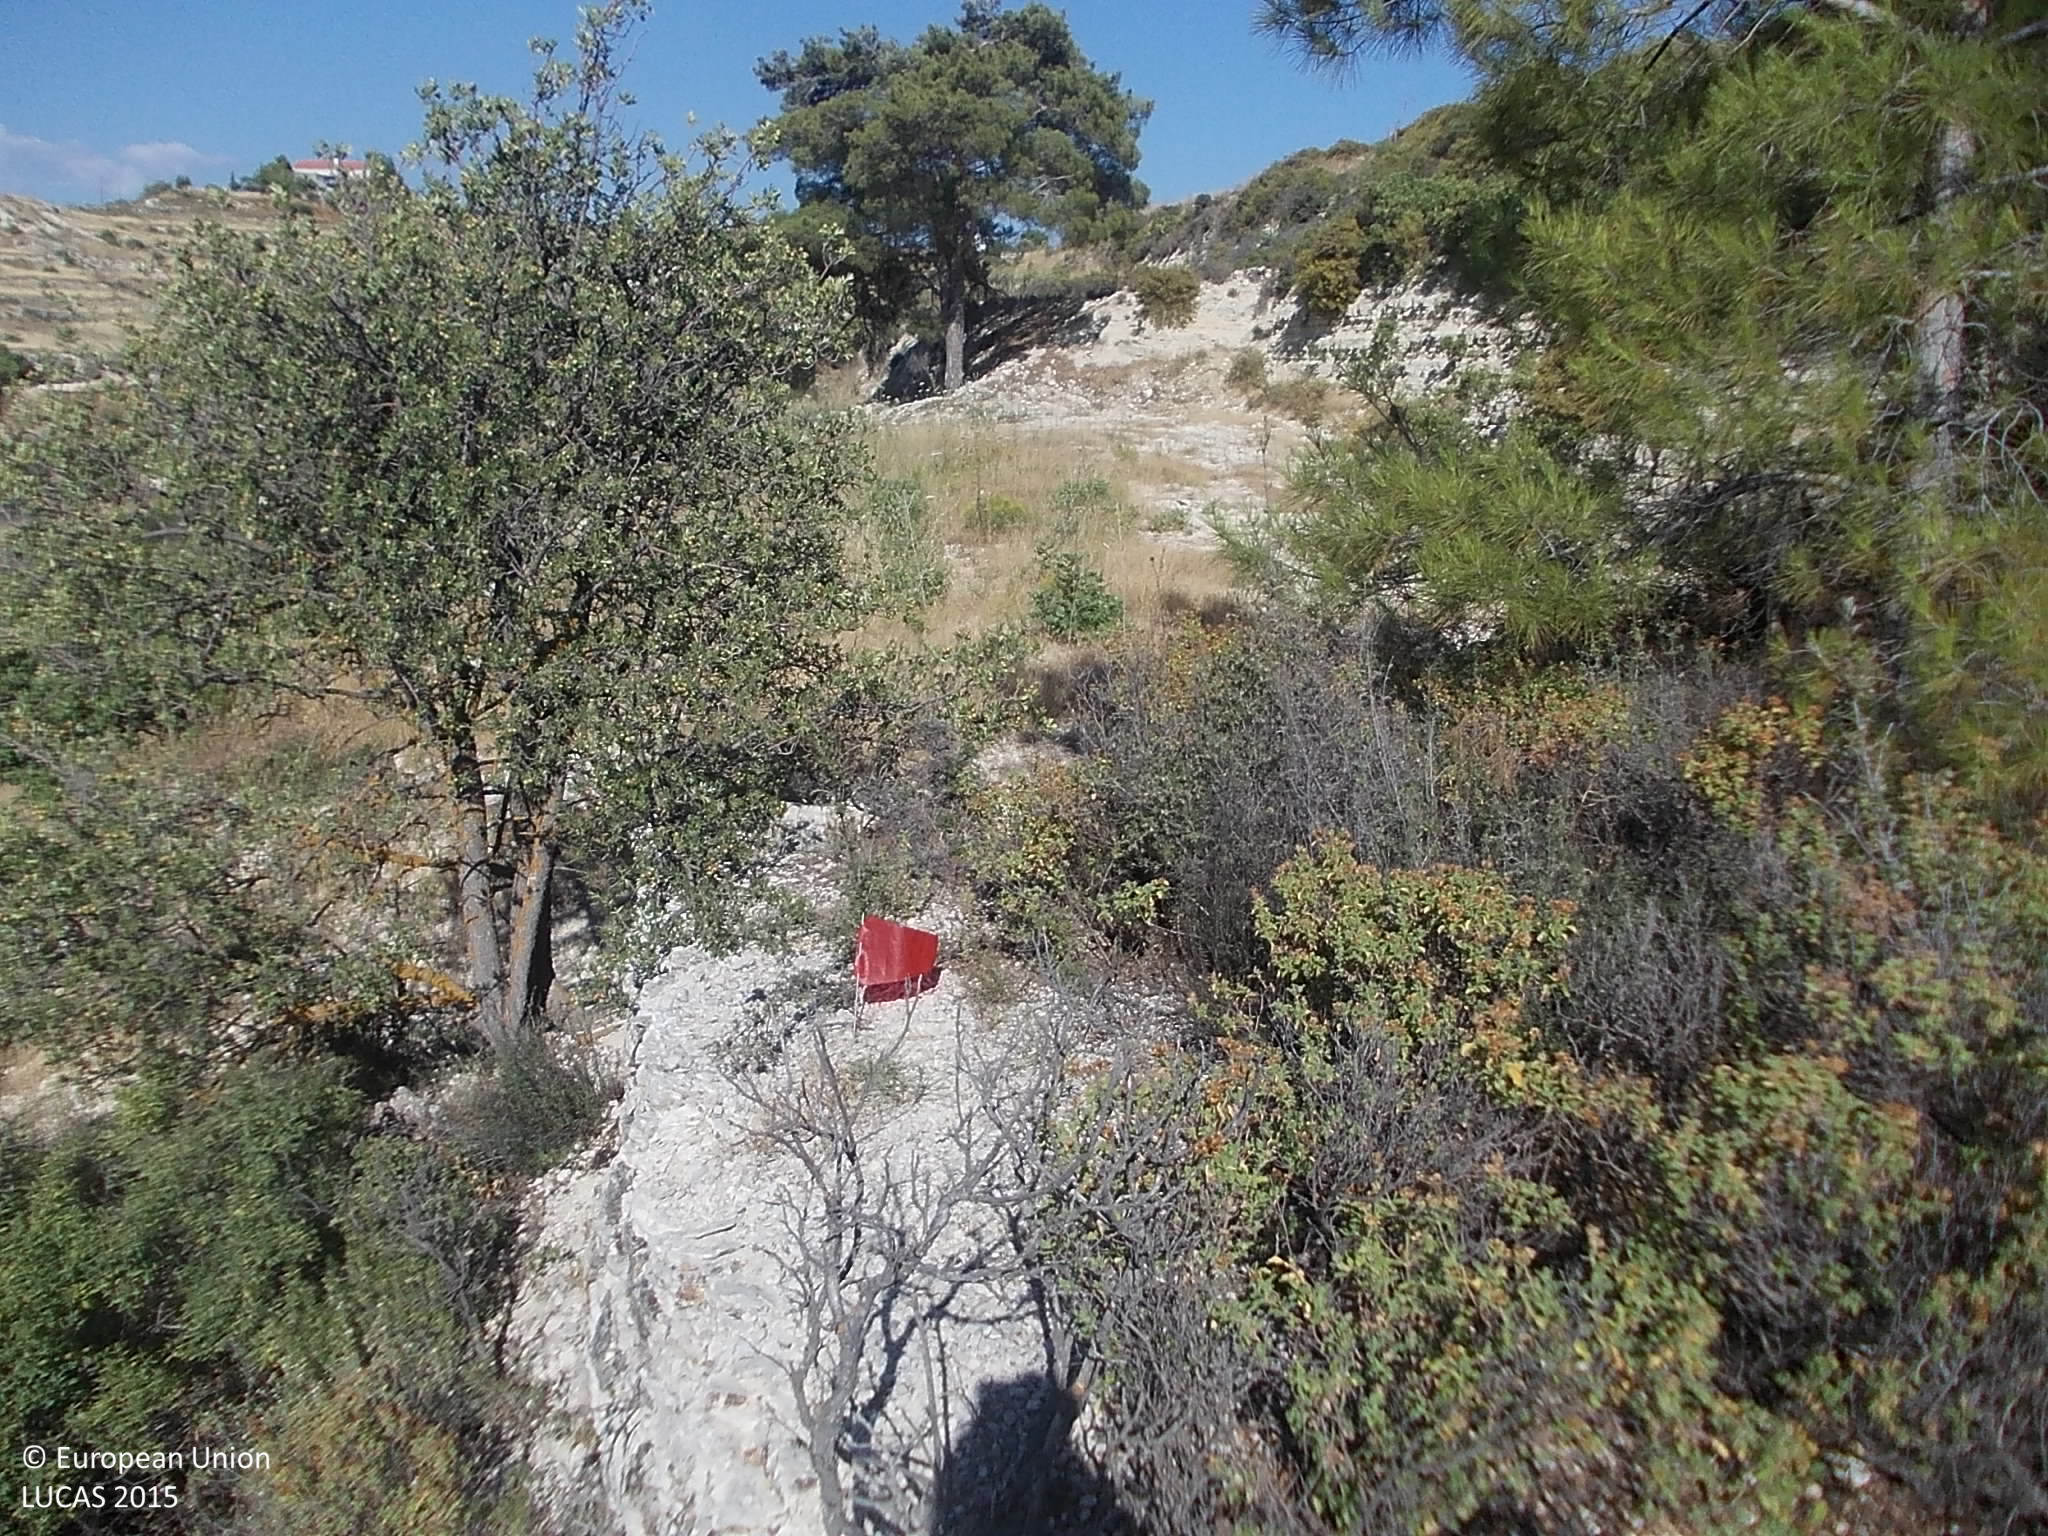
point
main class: Shrubland
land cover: Shrubland with sparse tree cover
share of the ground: 50 - 75 %
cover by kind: shrubs 55 %, herbaceous plants 25 %, unconsolidated bare surface 15 %, coniferous forest trees 5 %
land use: Semi-natural and natural areas not in use
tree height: < 5 m
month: July
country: CY
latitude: 34.8198
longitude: 32.8249
